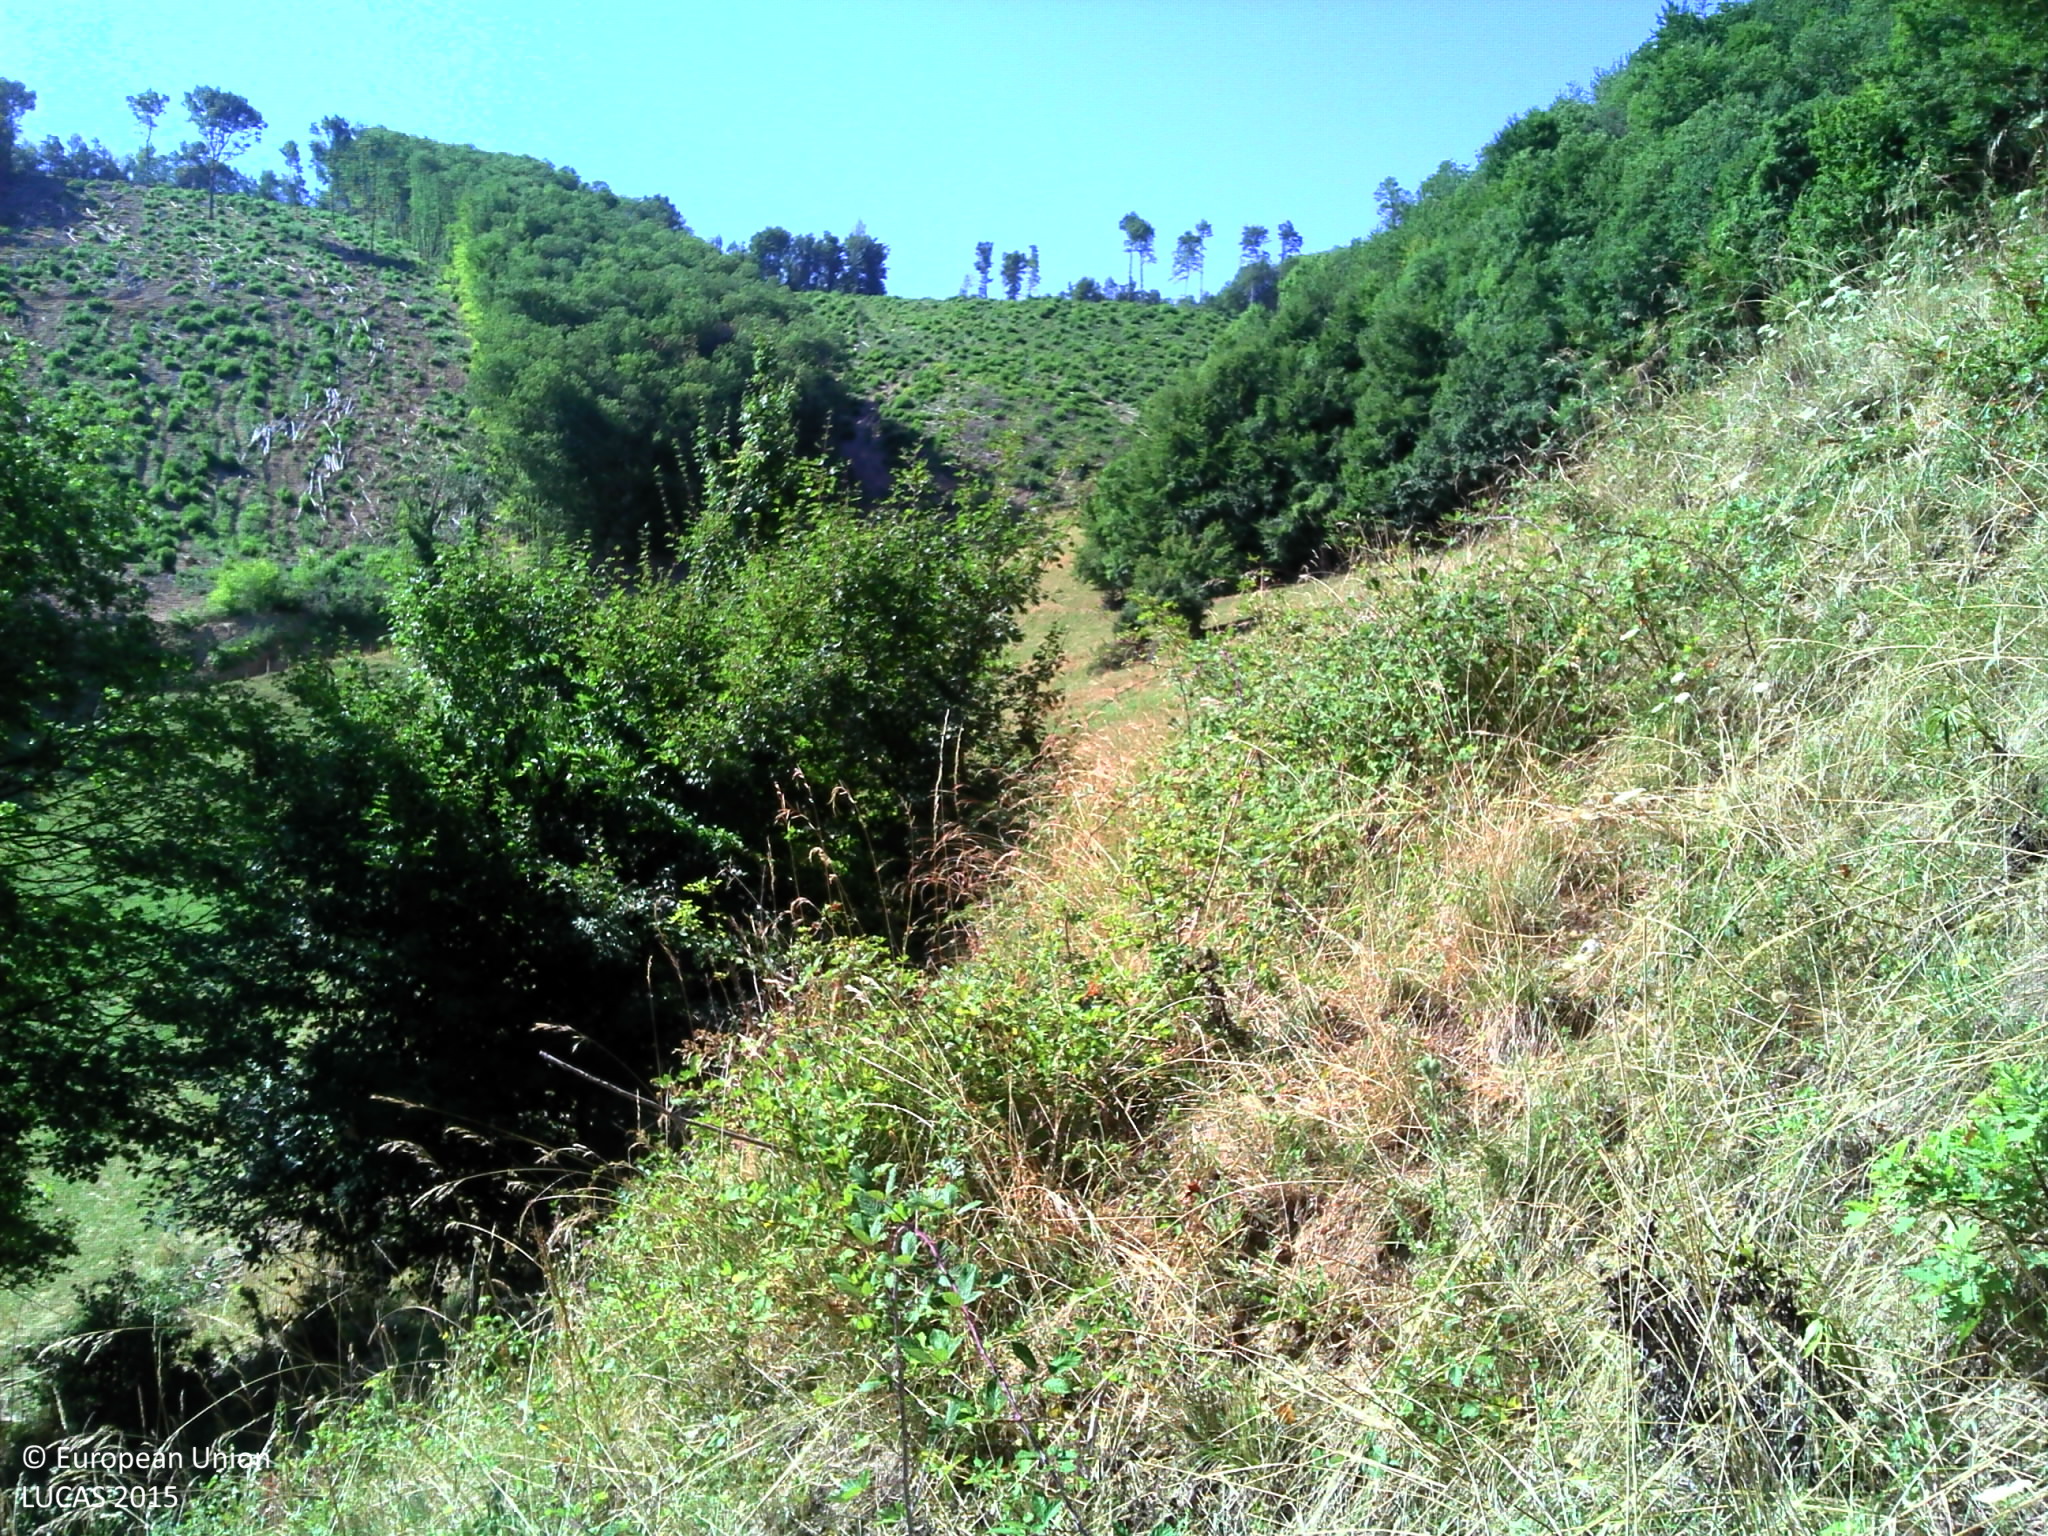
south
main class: Shrubland
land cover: Shrubland without tree cover
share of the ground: > 75 %
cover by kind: herbaceous plants 65 %, shrubs 35 %
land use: Agriculture (excluding fallow land and kitchen gardens)
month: July
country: FR
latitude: 45.2982
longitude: 5.4526
